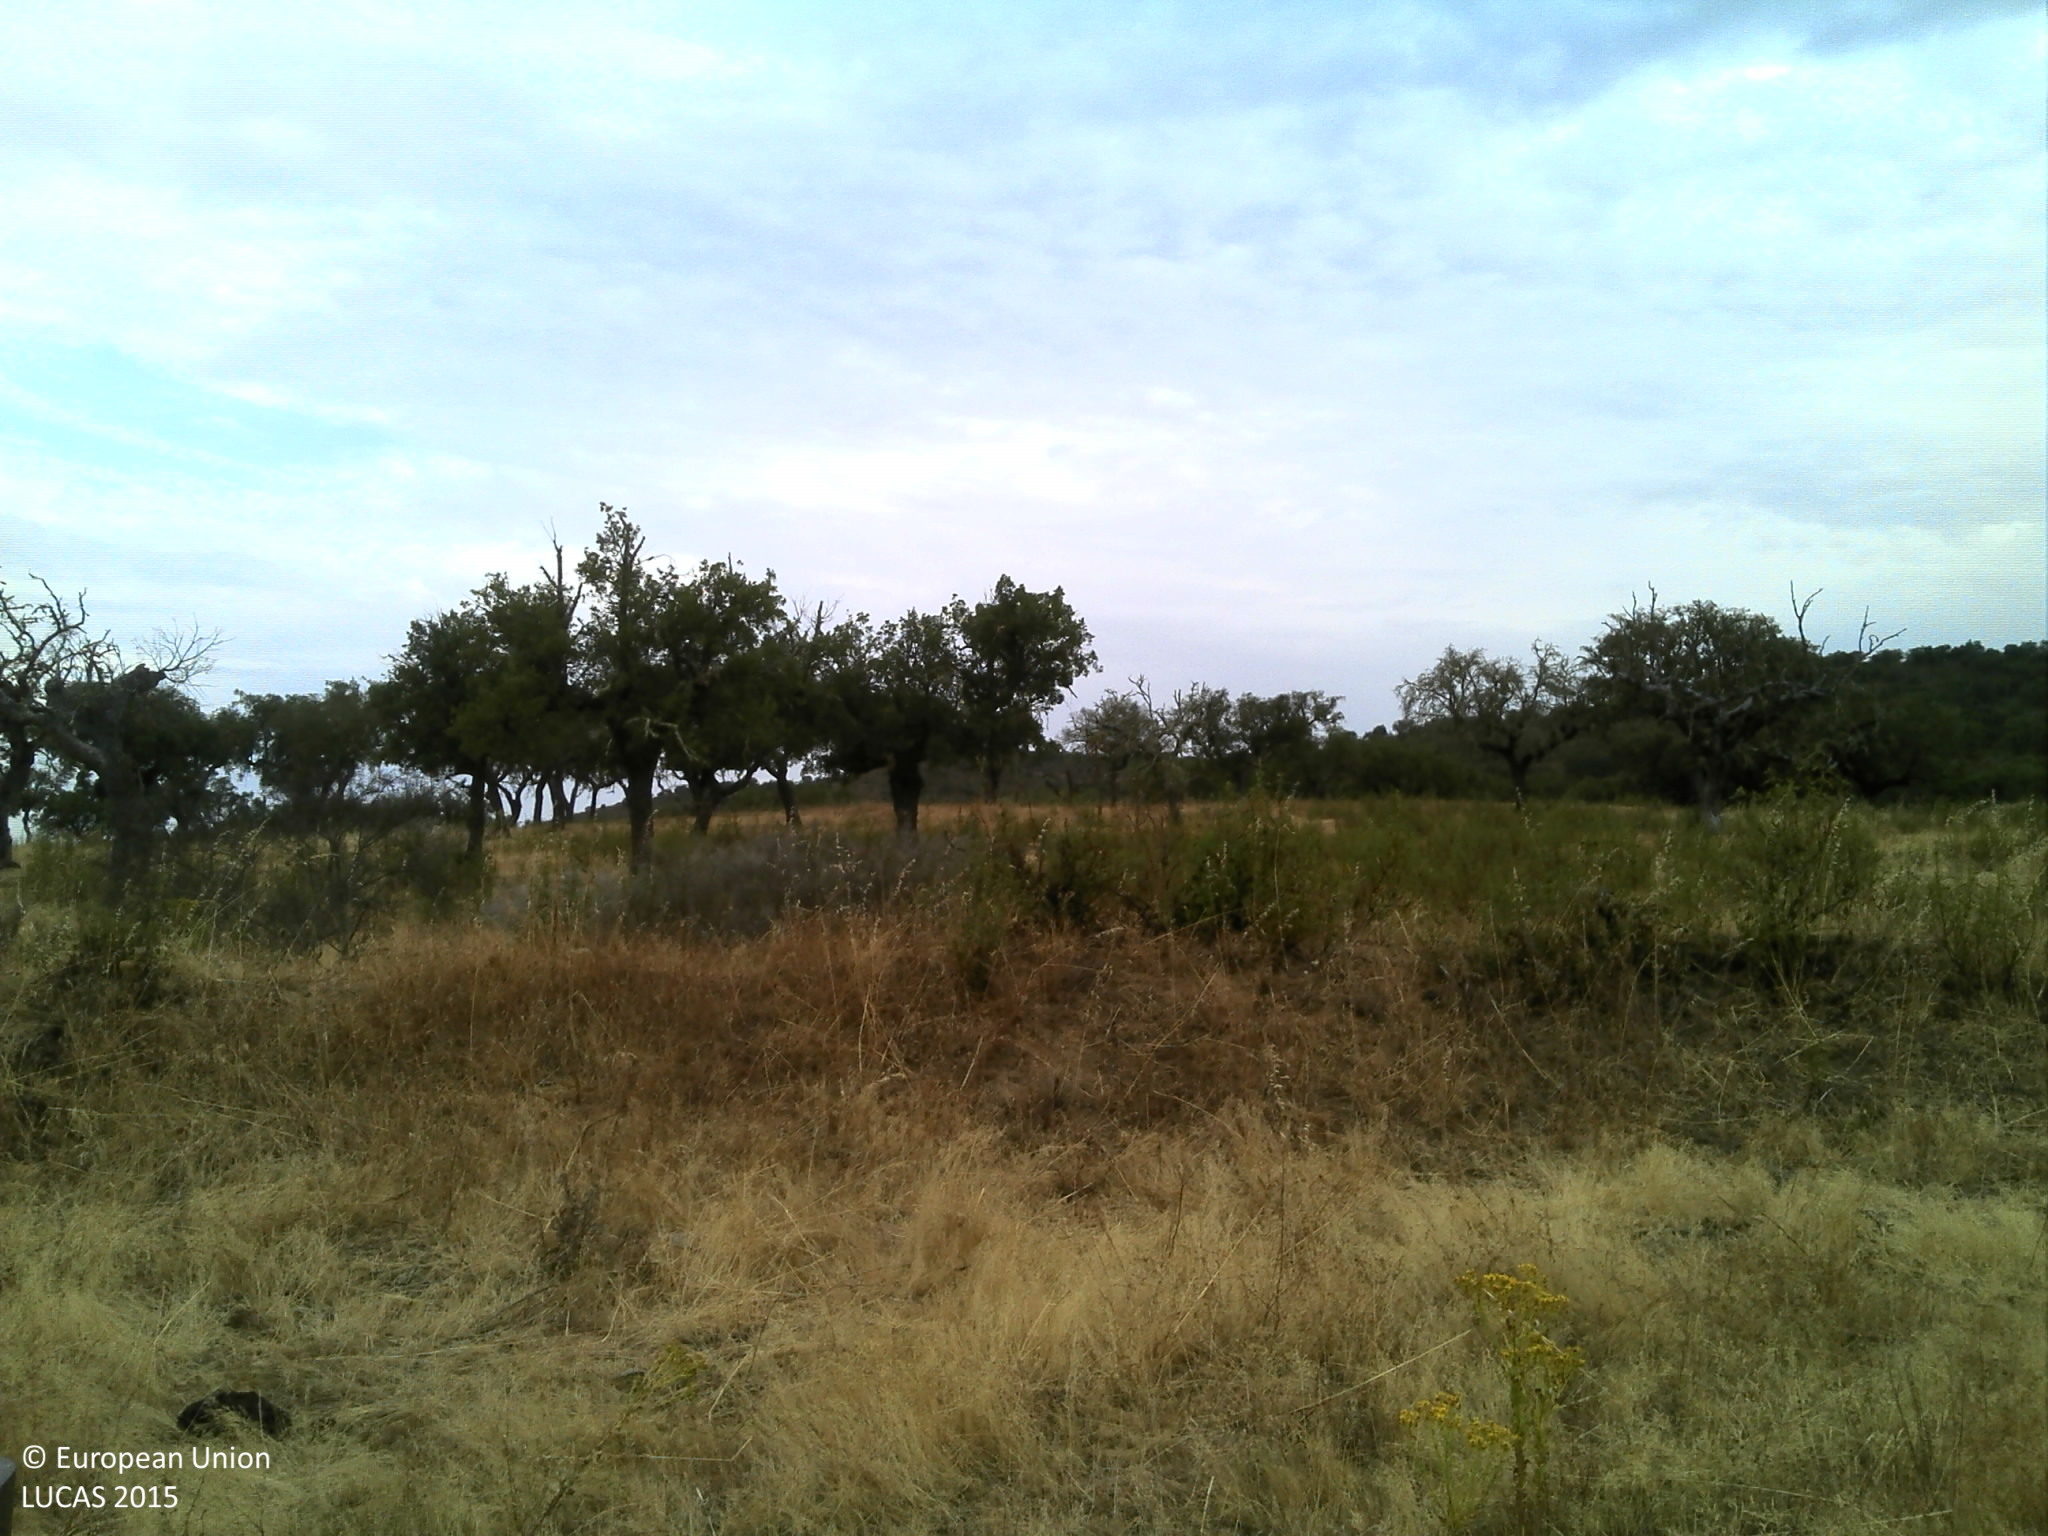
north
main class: Grassland
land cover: Grassland without tree/shrub cover
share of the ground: 25 - 50 %
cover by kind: unconsolidated bare surface 75 %, herbaceous plants 25 %
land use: Agriculture (excluding fallow land and kitchen gardens)
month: July
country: PT
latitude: 38.7967
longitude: -7.5712
